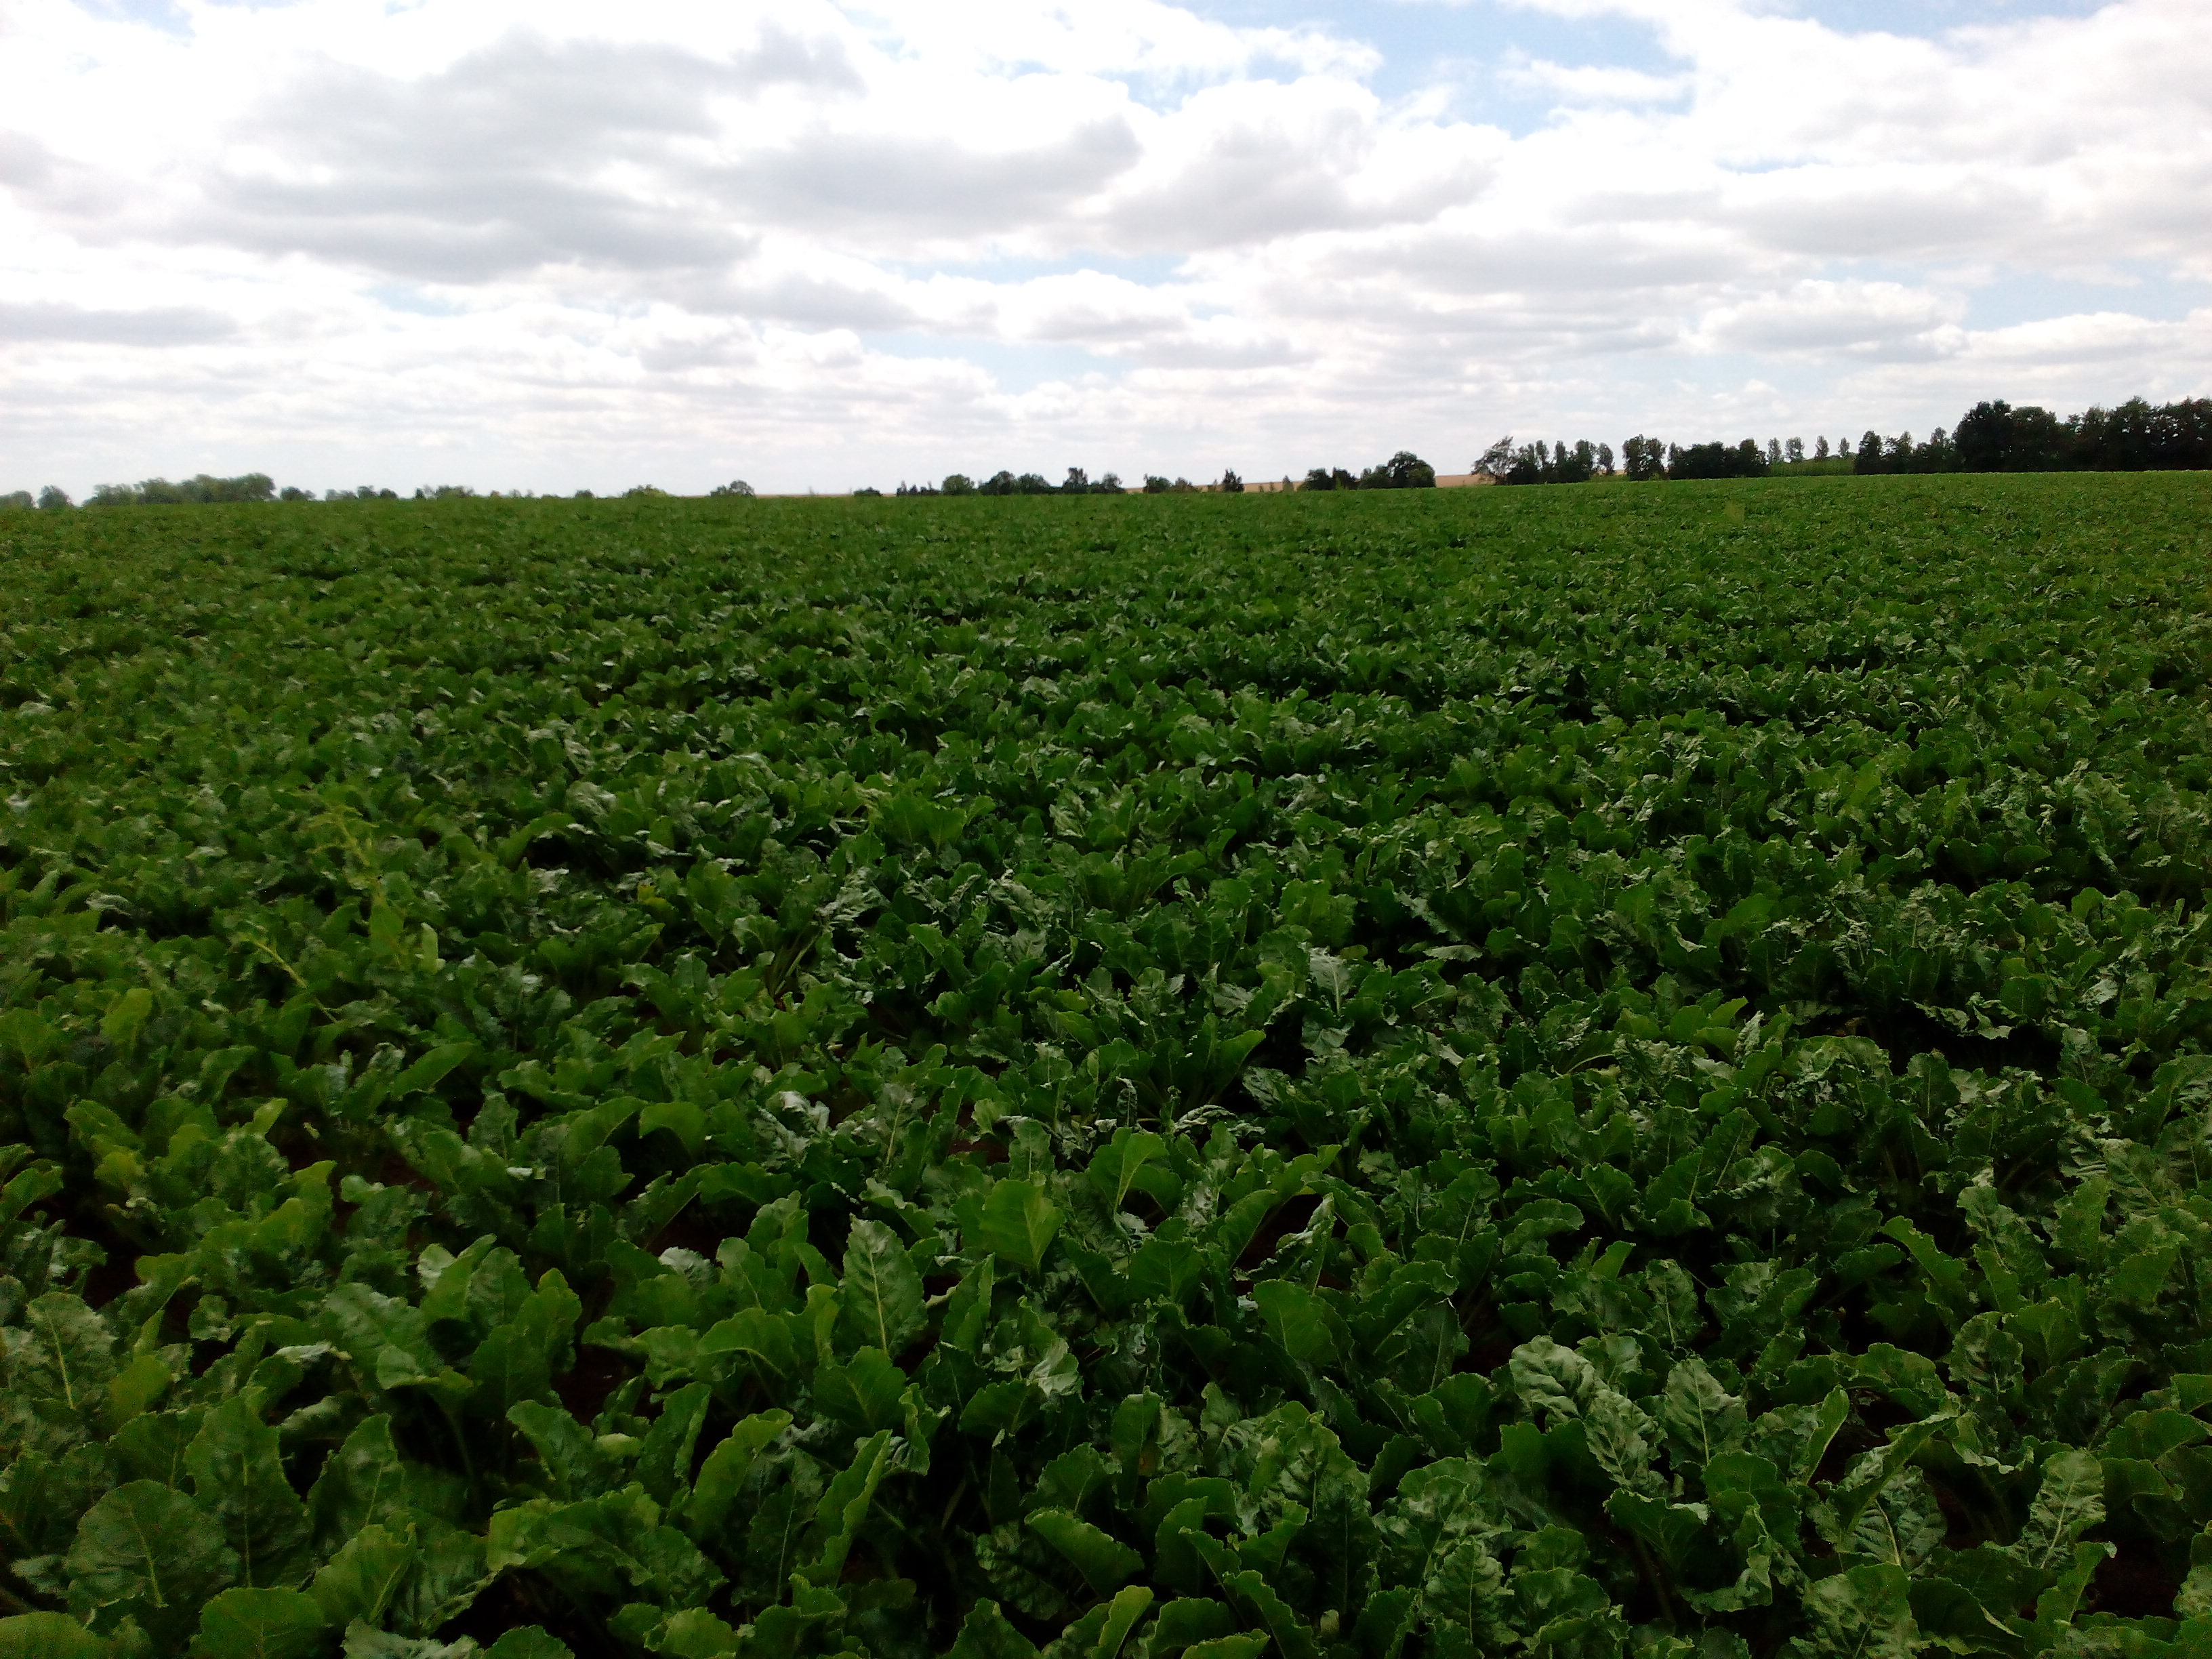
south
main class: Cropland
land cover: Sugar beet
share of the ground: > 75 %
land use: Agriculture (excluding fallow land and kitchen gardens)
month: July
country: DE
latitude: 51.1871
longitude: 10.9583
